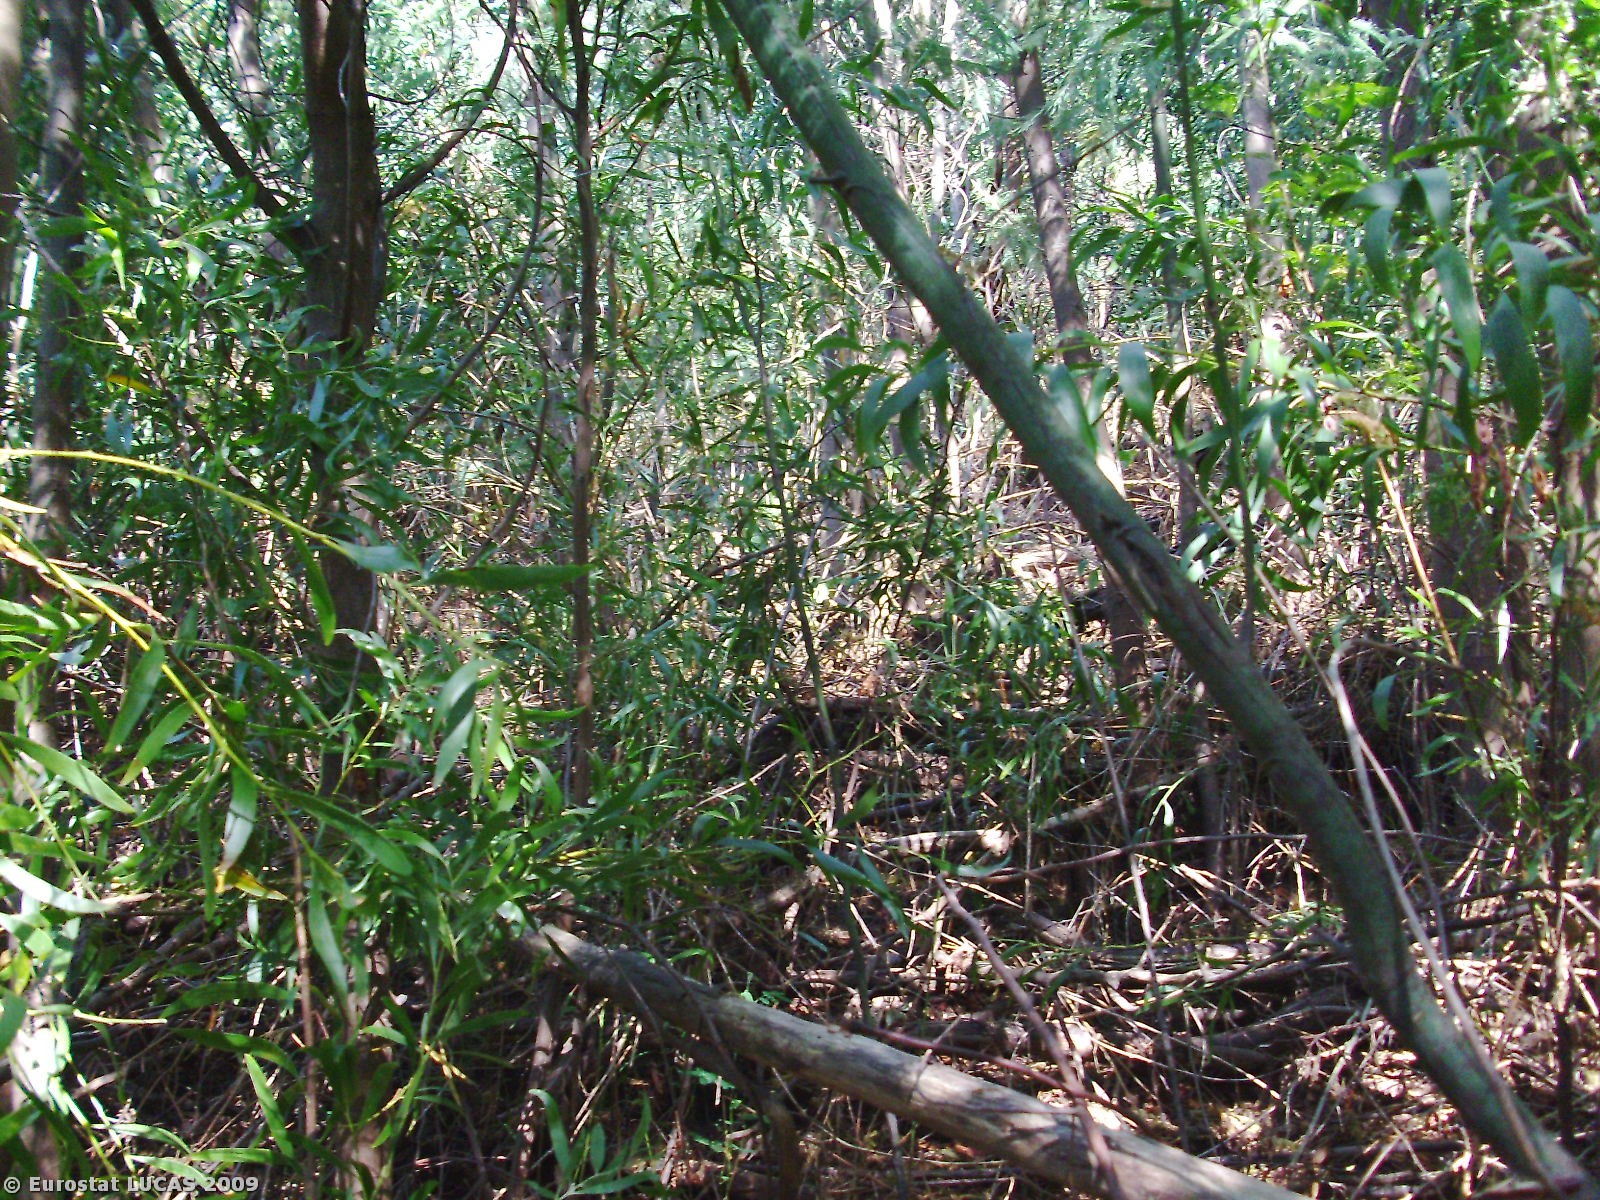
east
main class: Woodland
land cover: Broadleaved woodland
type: mesophytic deciduous forest
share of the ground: > 75 %
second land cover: Shrubland with sparse tree cover
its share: 10 - 25 %
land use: Forestry
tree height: > 5 m
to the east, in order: Broadleaved woodland; Shrubland with sparse tree cover; Broadleaved woodland; Tracks; Shrubland with sparse tree cover; Tracks; Shrubland with sparse tree cover; Broadleaved woodland; Shrubland with sparse tree cover; Broadleaved woodland
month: August
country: PT
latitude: 40.1193
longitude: -8.2044
